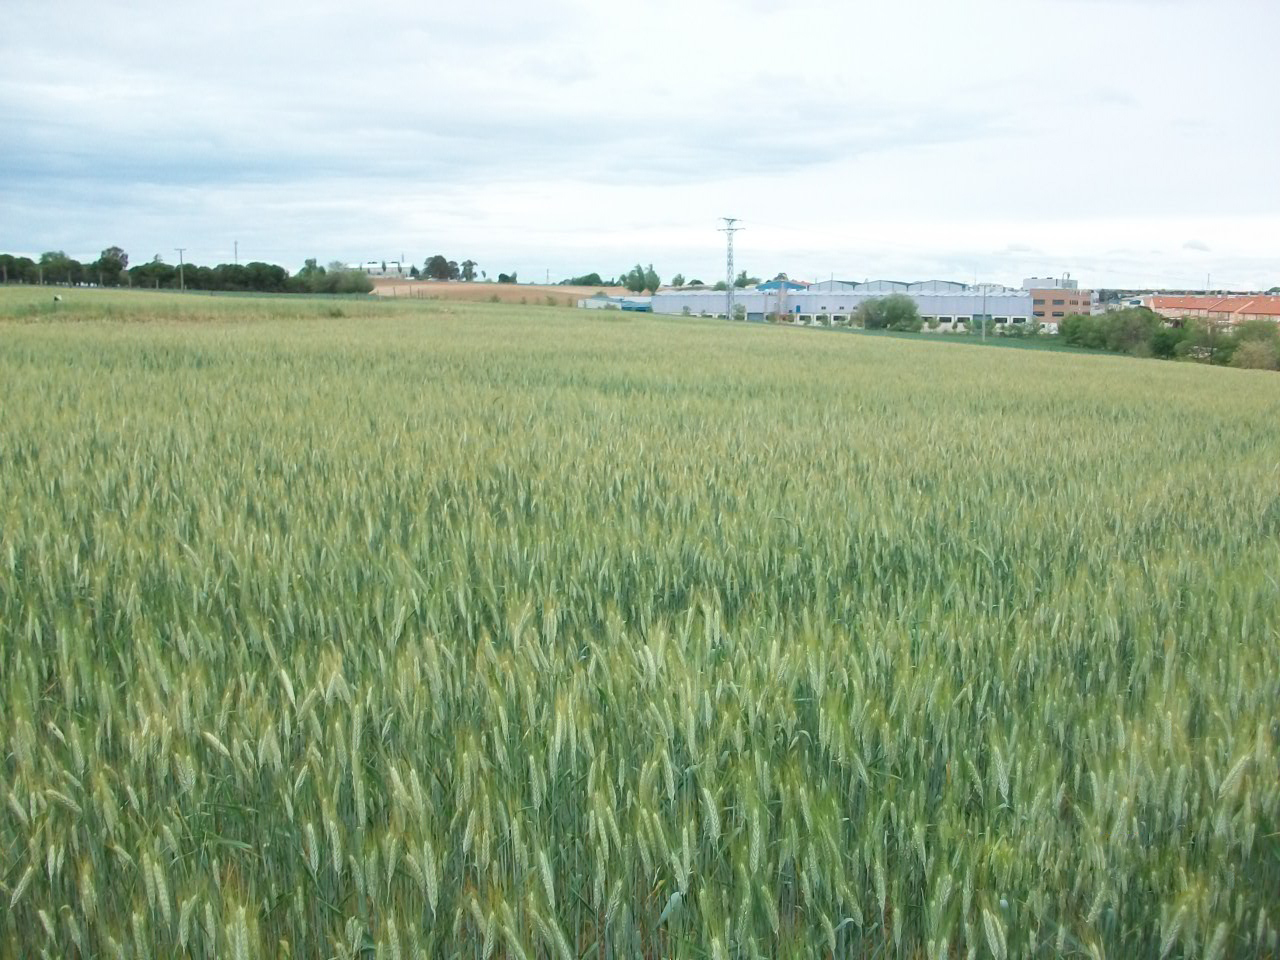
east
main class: Cropland
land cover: Common wheat
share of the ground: > 75 %
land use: Agriculture (excluding fallow land and kitchen gardens)
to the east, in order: Common wheat; Grass margins; Tracks; Grass margins; Common wheat; Grass margins; Fences; Barley; Electric lines; Barley
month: April
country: ES
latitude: 40.2686
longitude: -3.8550
